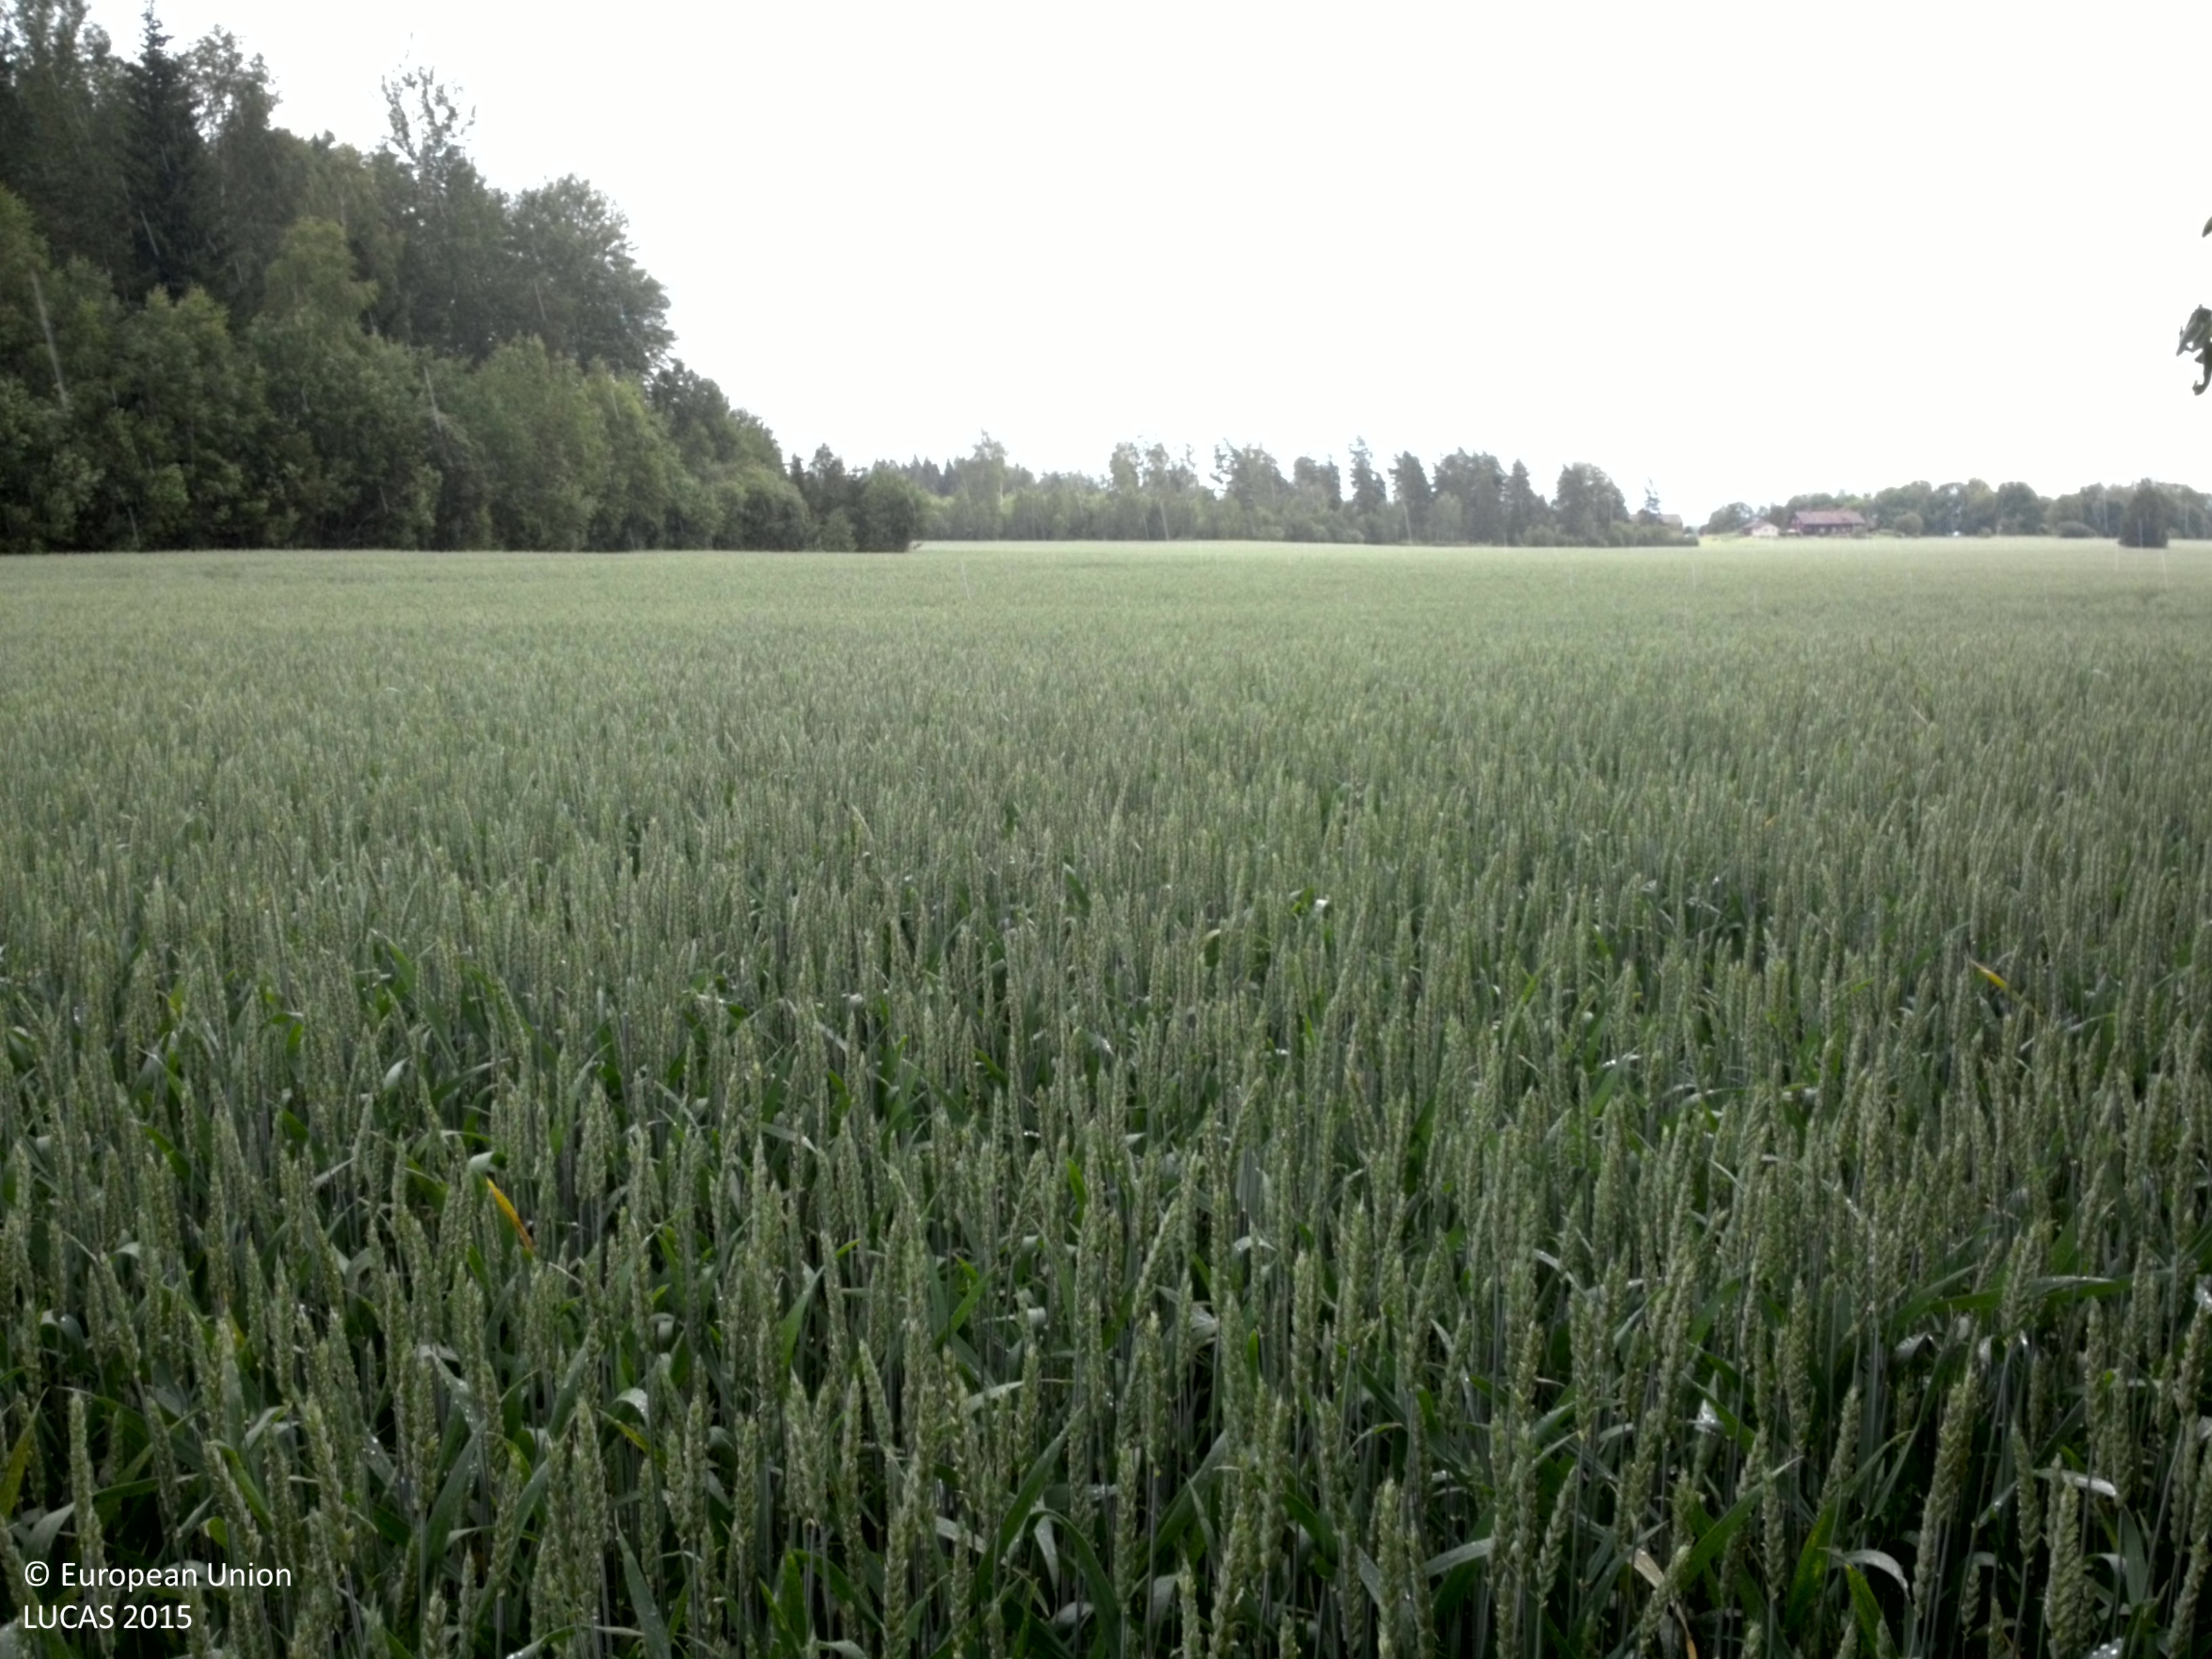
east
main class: Cropland
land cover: Common wheat
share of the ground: > 75 %
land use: Agriculture (excluding fallow land and kitchen gardens)
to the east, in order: Common wheat
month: July
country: SE
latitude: 60.1229
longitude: 17.2085
